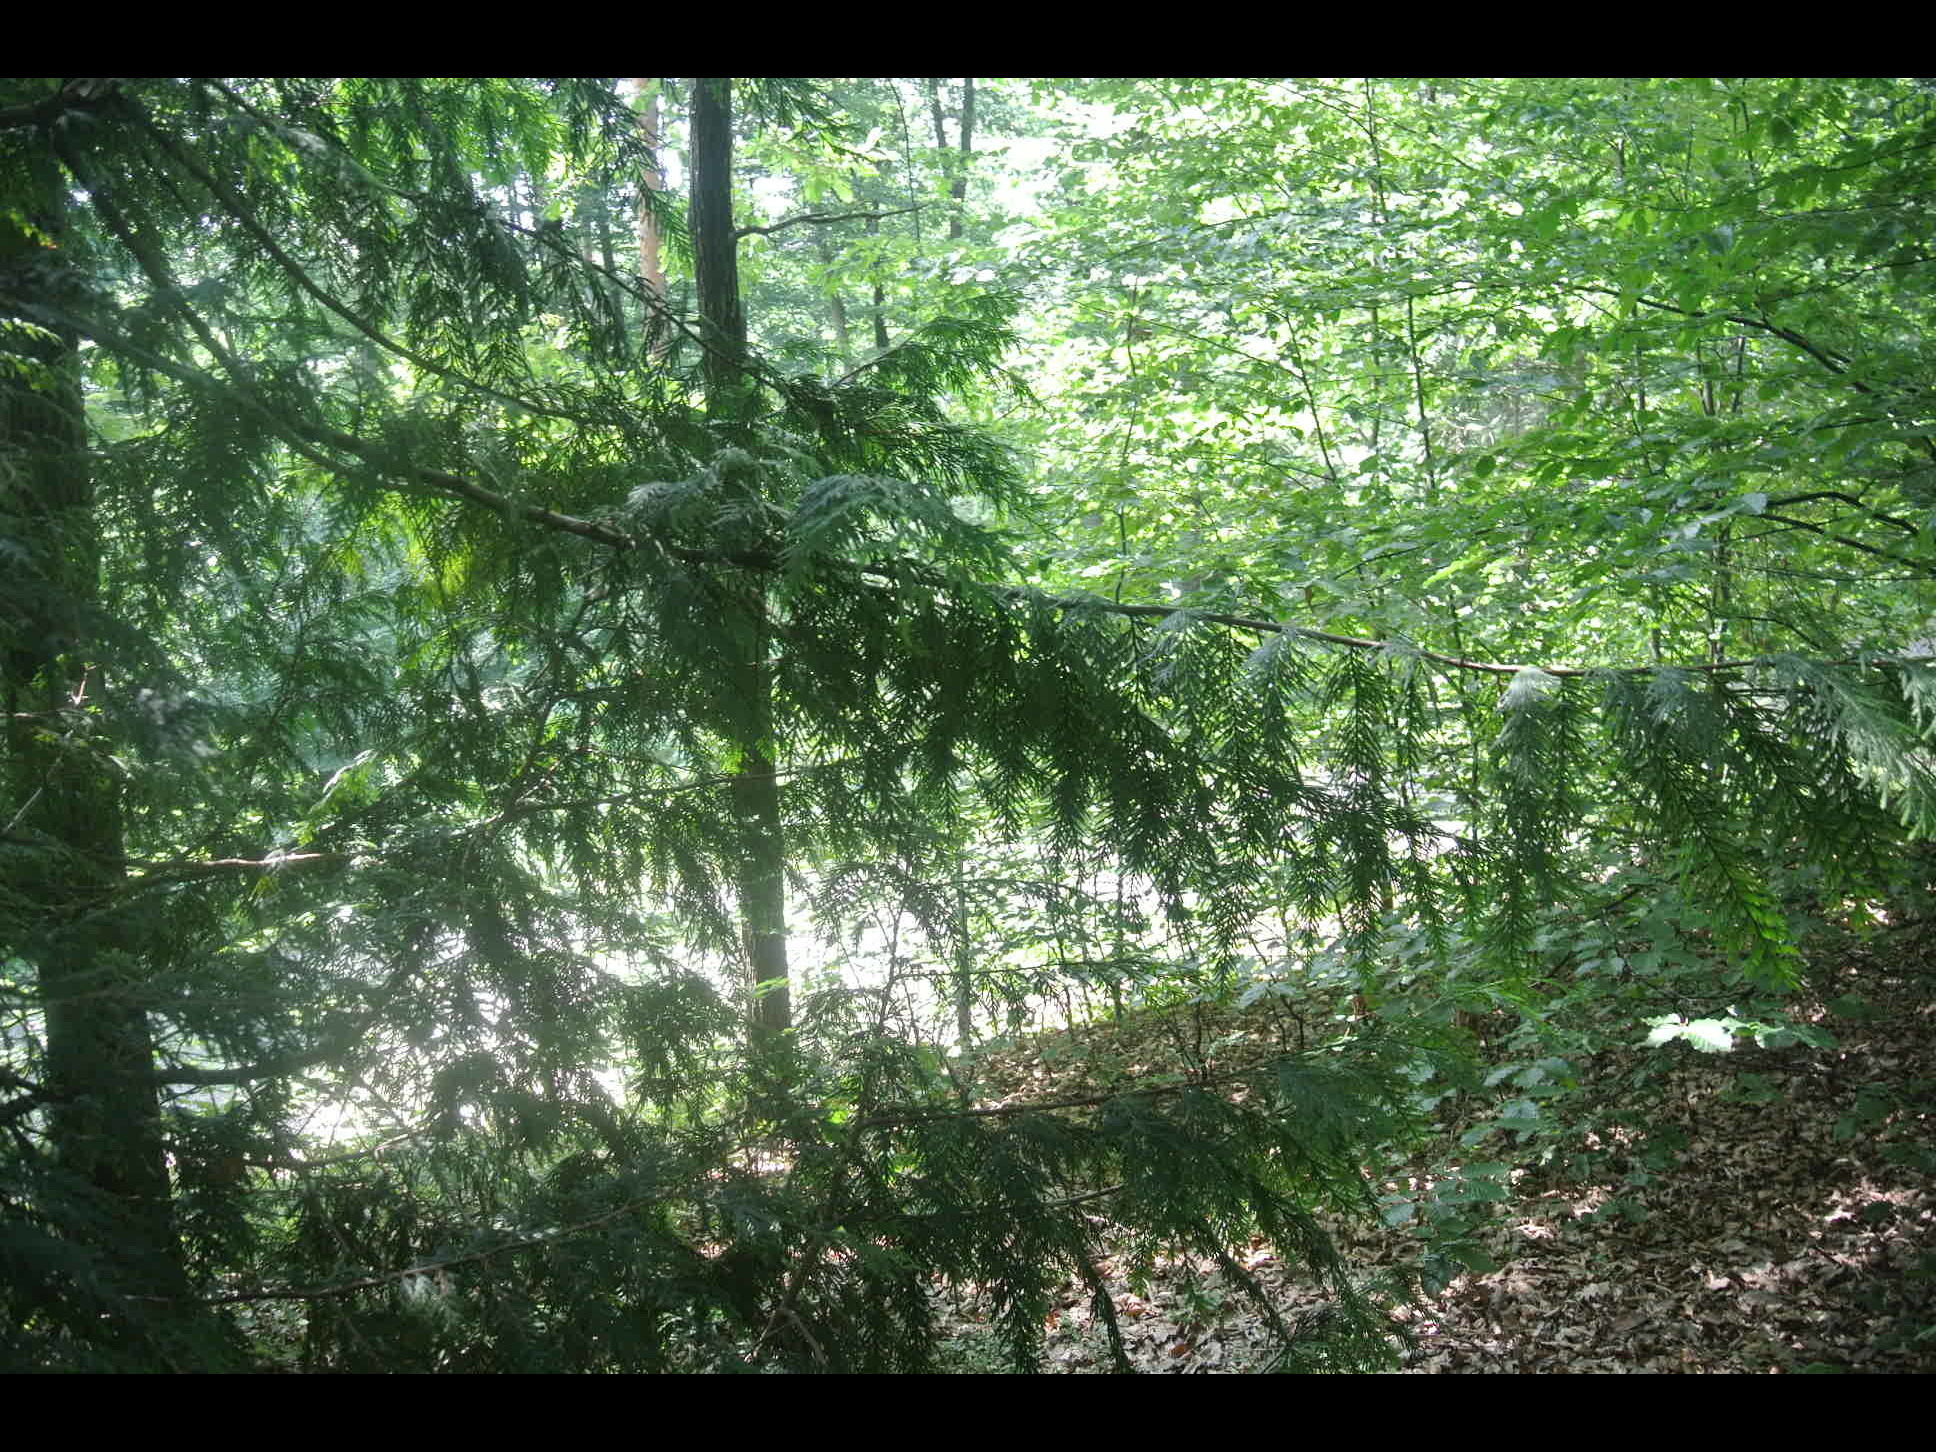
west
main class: Woodland
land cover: Broadleaved woodland
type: beech forest
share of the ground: > 75 %
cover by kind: broadleaved forest trees 95 %, coniferous forest trees 5 %
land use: Forestry
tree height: > 5 m
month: July
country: AT
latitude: 47.4039
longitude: 16.4301
